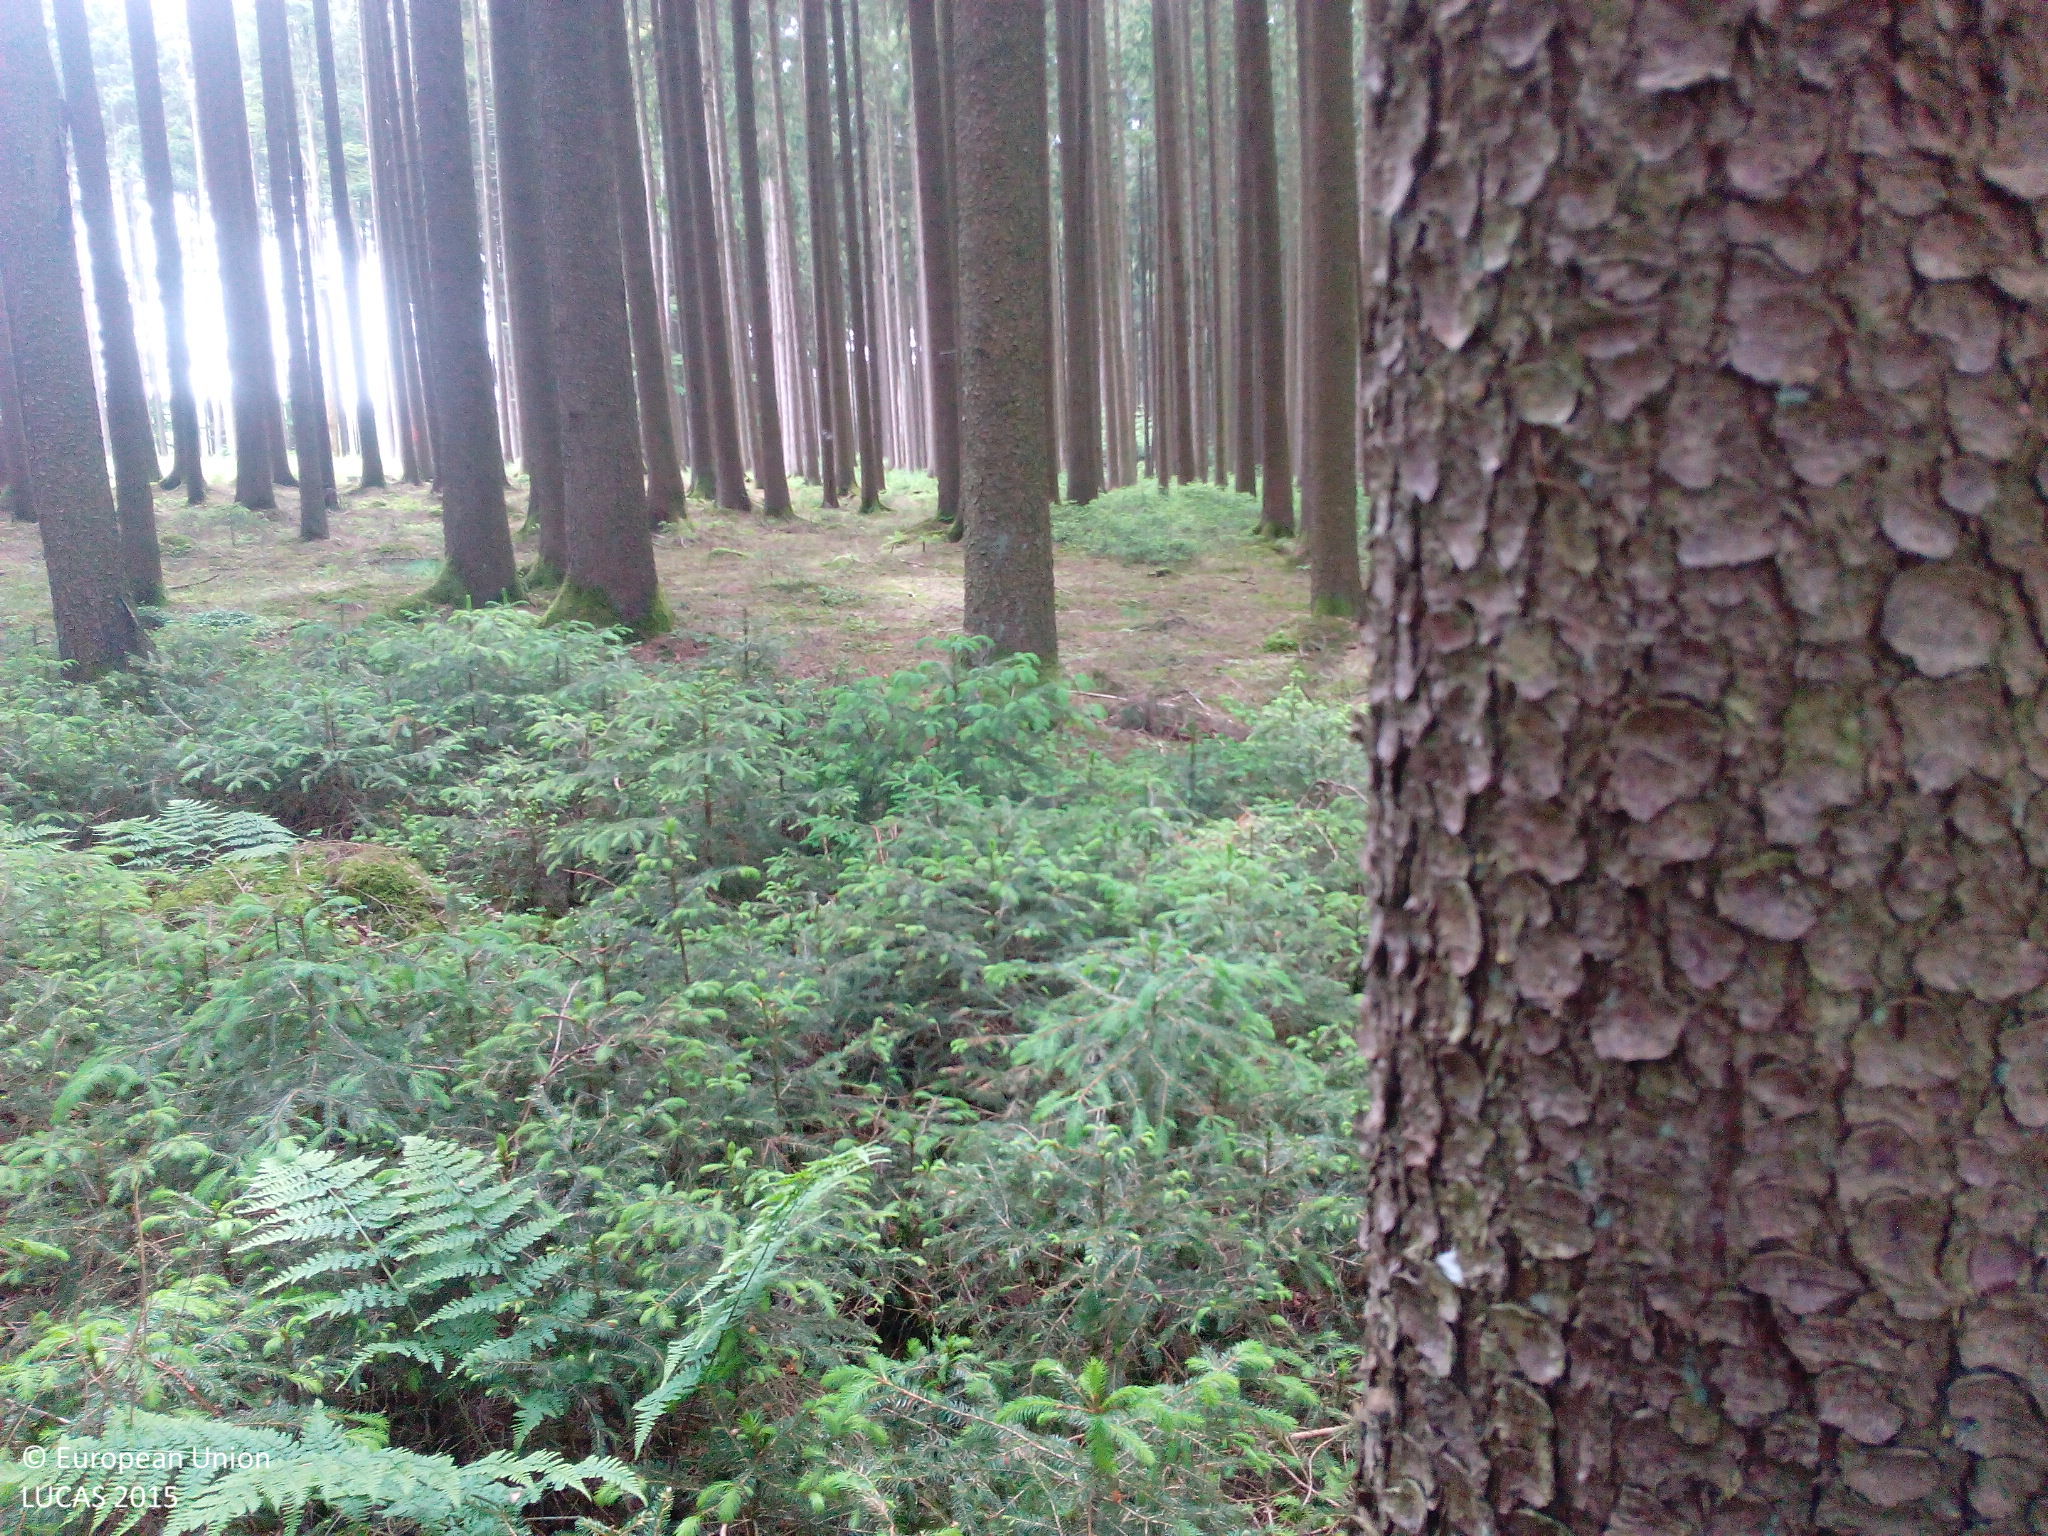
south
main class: Woodland
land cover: Spruce dominated coniferous woodland
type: hemiboreal forest and nemoral coniferous forest and mixed broadleaved-coniferous forest
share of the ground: > 75 %
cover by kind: coniferous forest trees 100 %
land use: Forestry
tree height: > 5 m
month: May
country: DE
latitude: 48.0613
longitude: 10.2548
